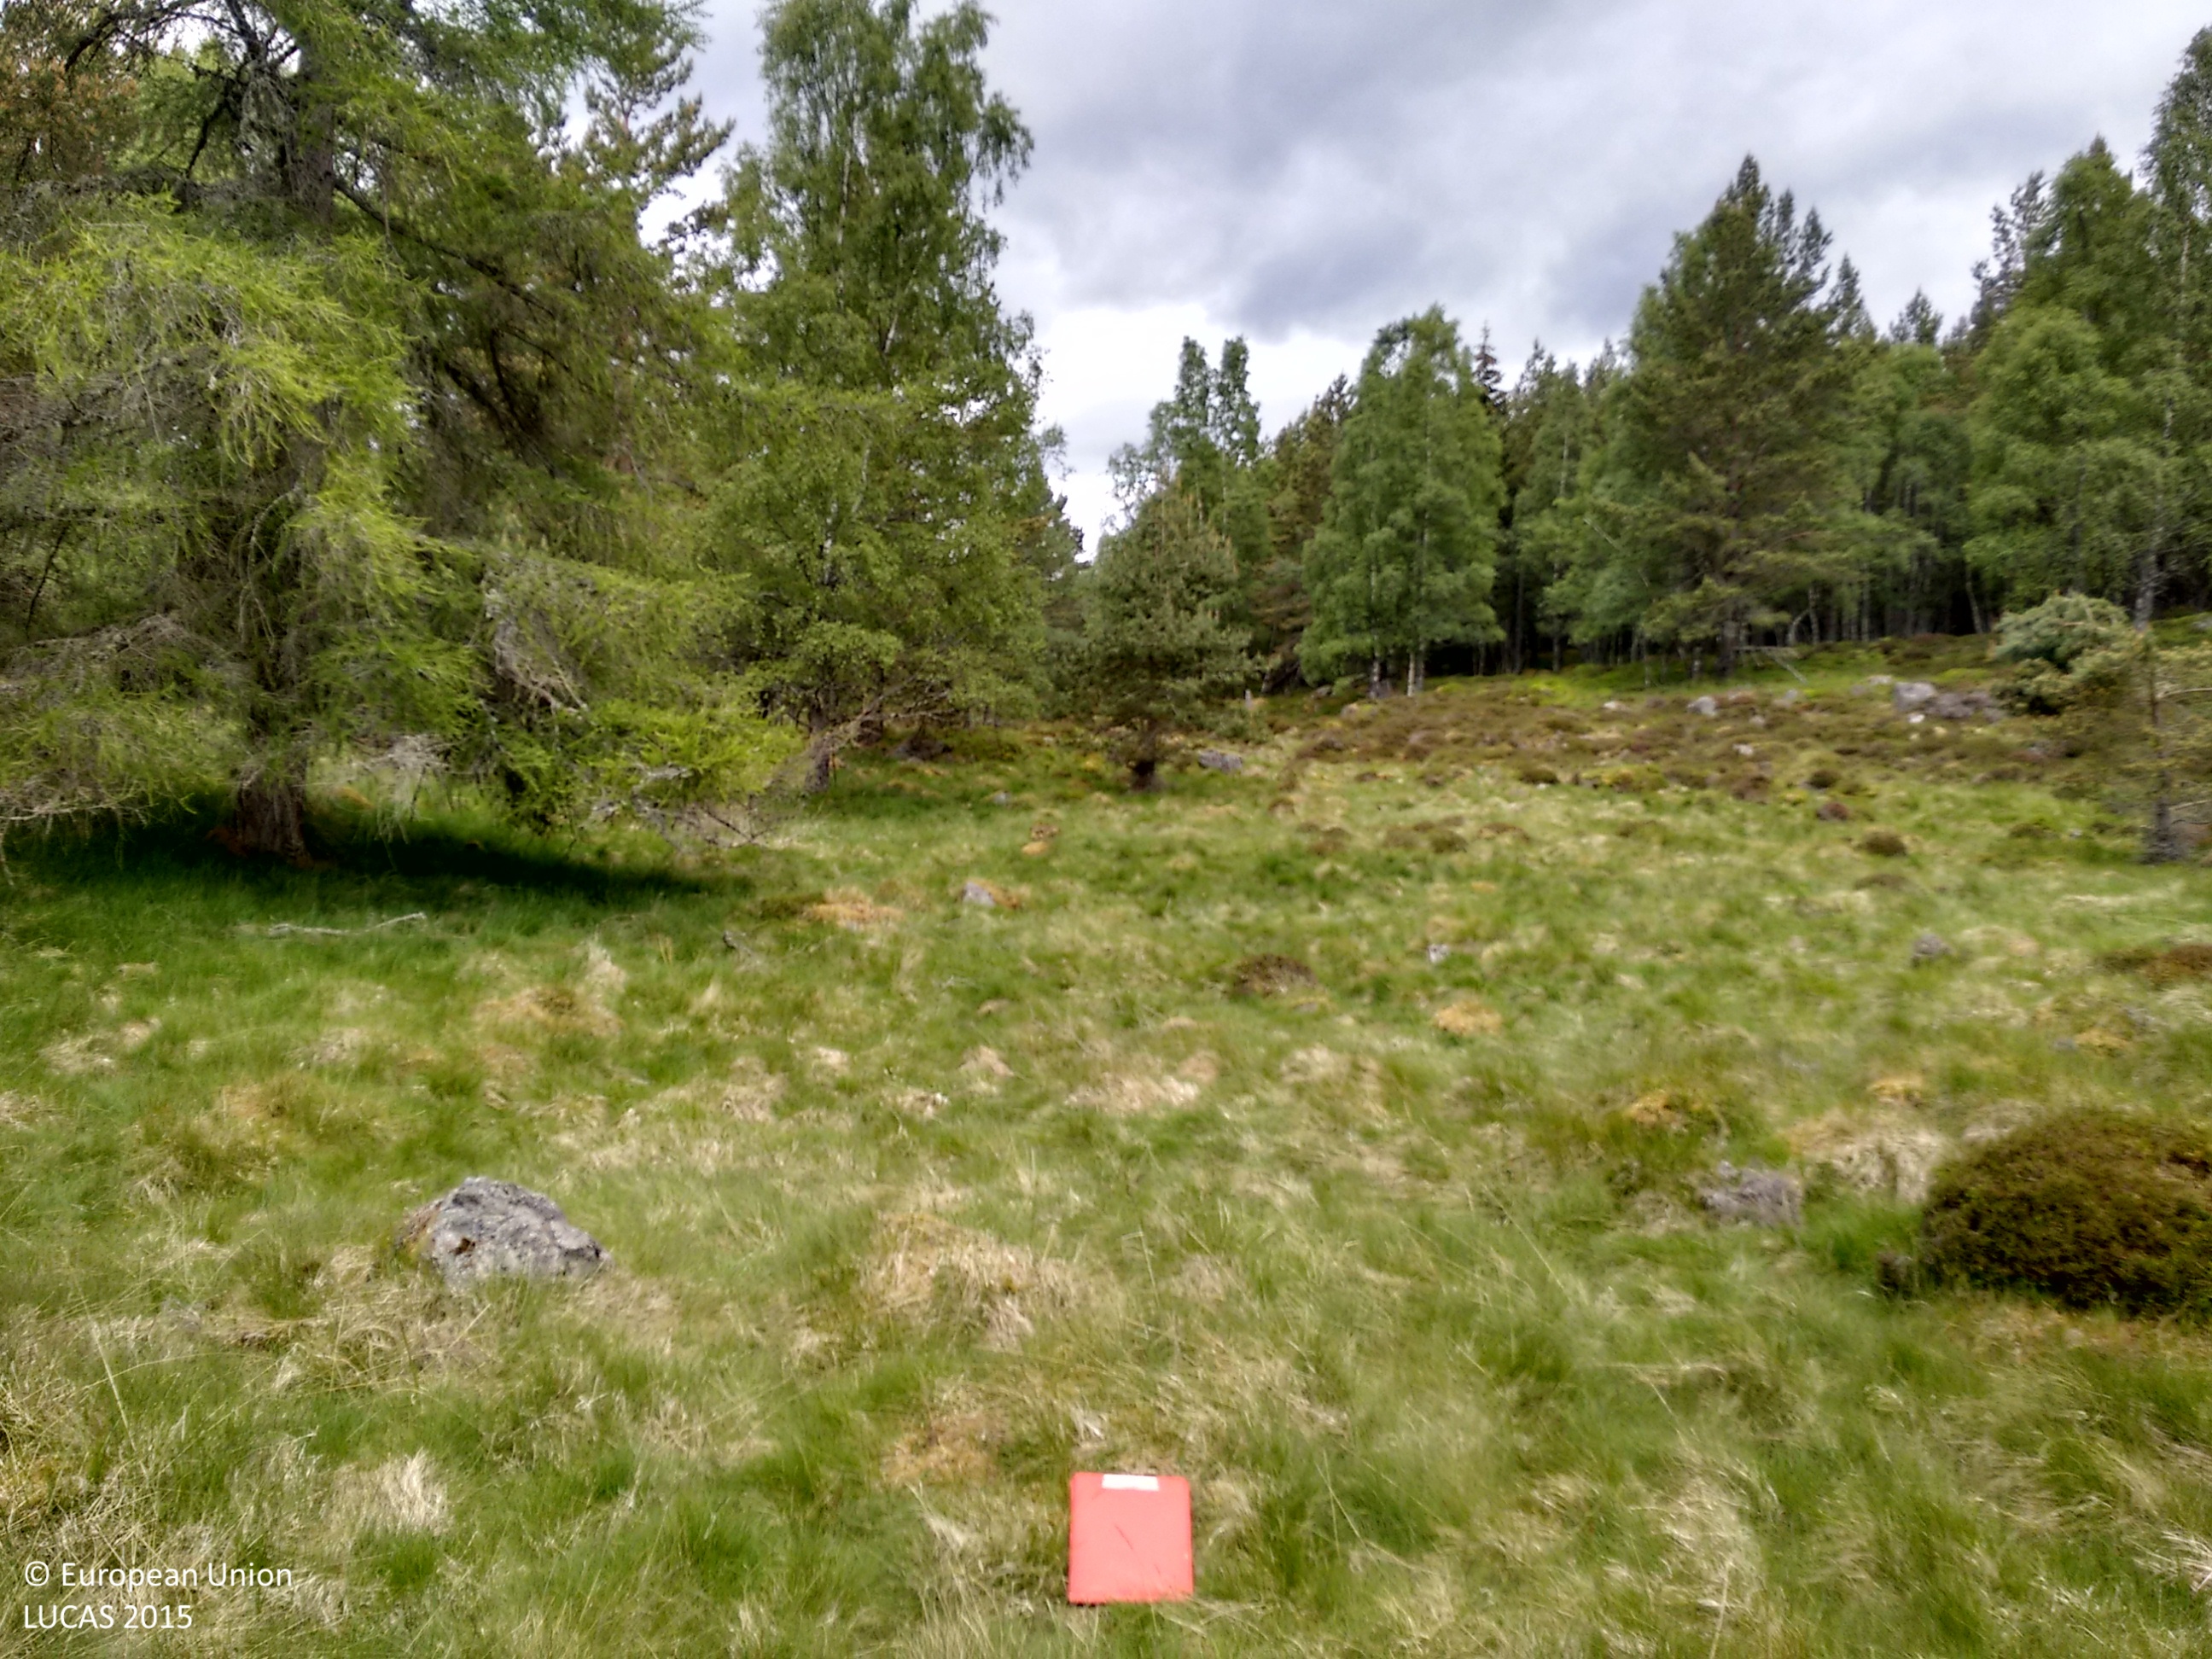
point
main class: Woodland
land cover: Pine dominated coniferous woodland
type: exotic forest
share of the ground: > 75 %
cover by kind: herbaceous plants 60 %, coniferous forest trees 30 %, shrubs 10 %
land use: Semi-natural and natural areas not in use
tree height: > 5 m
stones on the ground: < 10 %
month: June
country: GB
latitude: 57.0317
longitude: -3.2325
